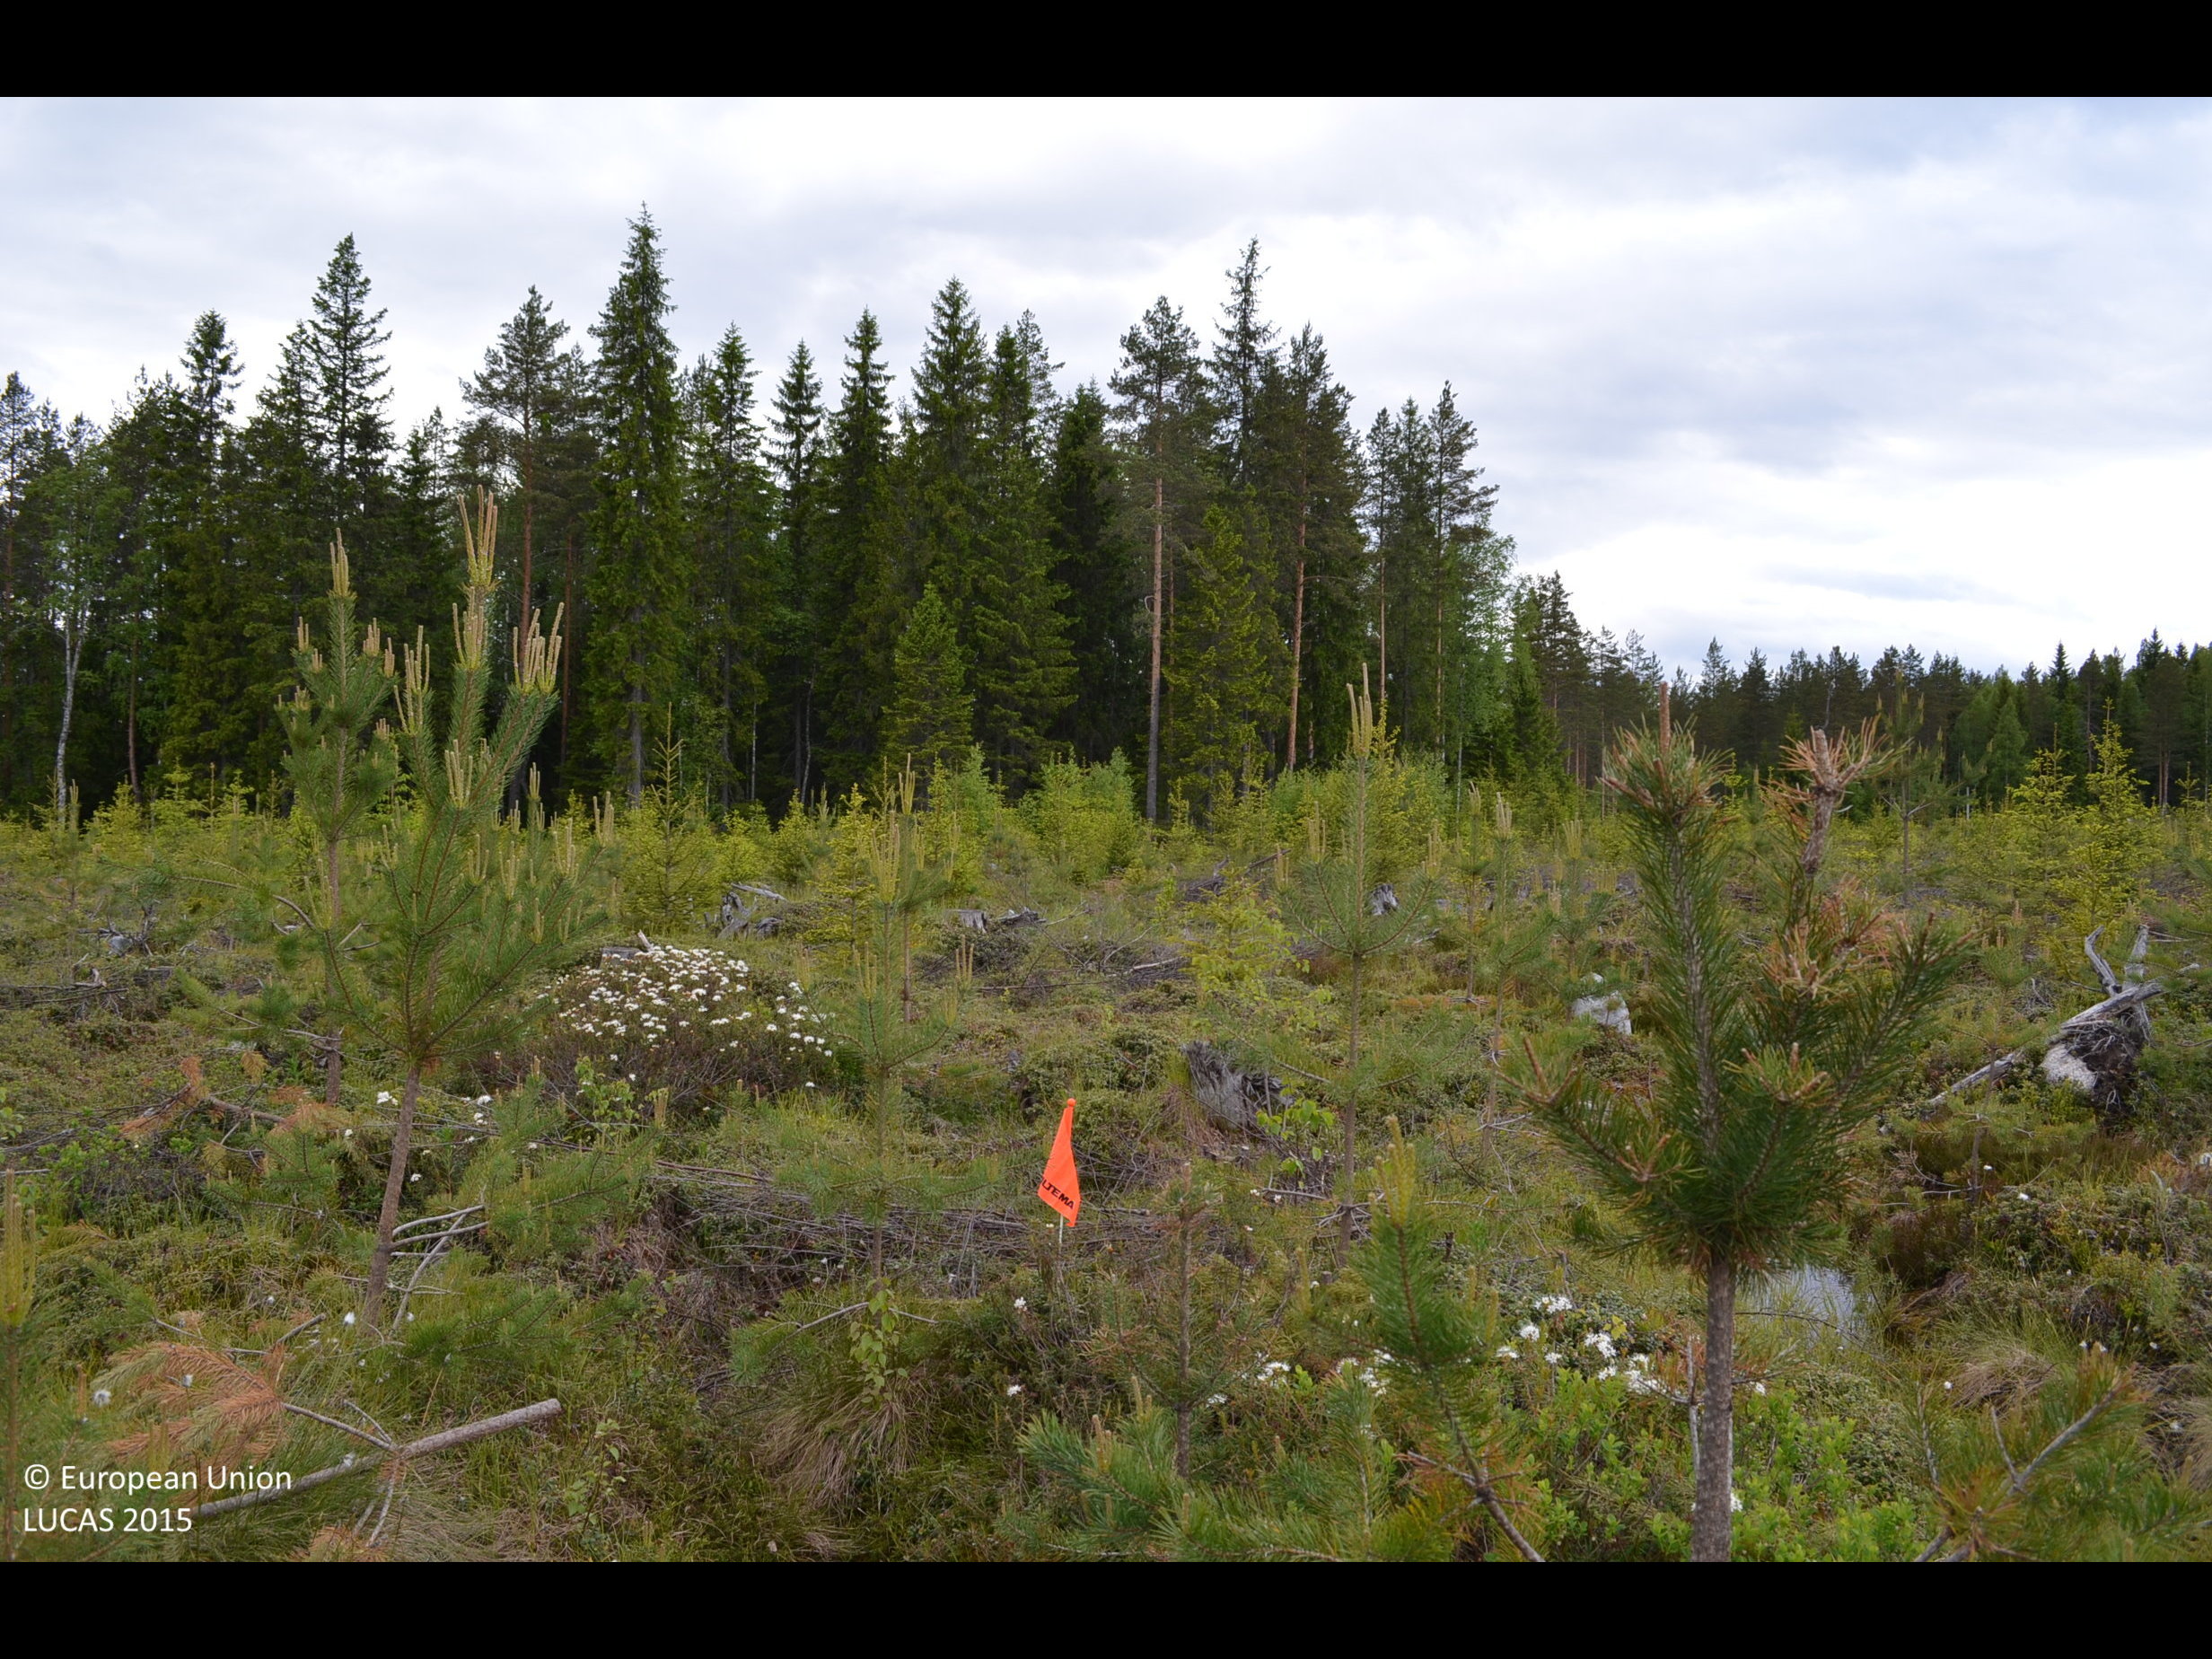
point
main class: Woodland
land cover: Other coniferous woodland
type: boreal forest
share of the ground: 25 - 50 %
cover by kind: shrubs 45 %, coniferous forest trees 35 %, lichens and mosses 10 %, herbaceous plants 5 %
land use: Forestry
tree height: < 5 m
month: June
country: FI
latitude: 61.9019
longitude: 23.3779
